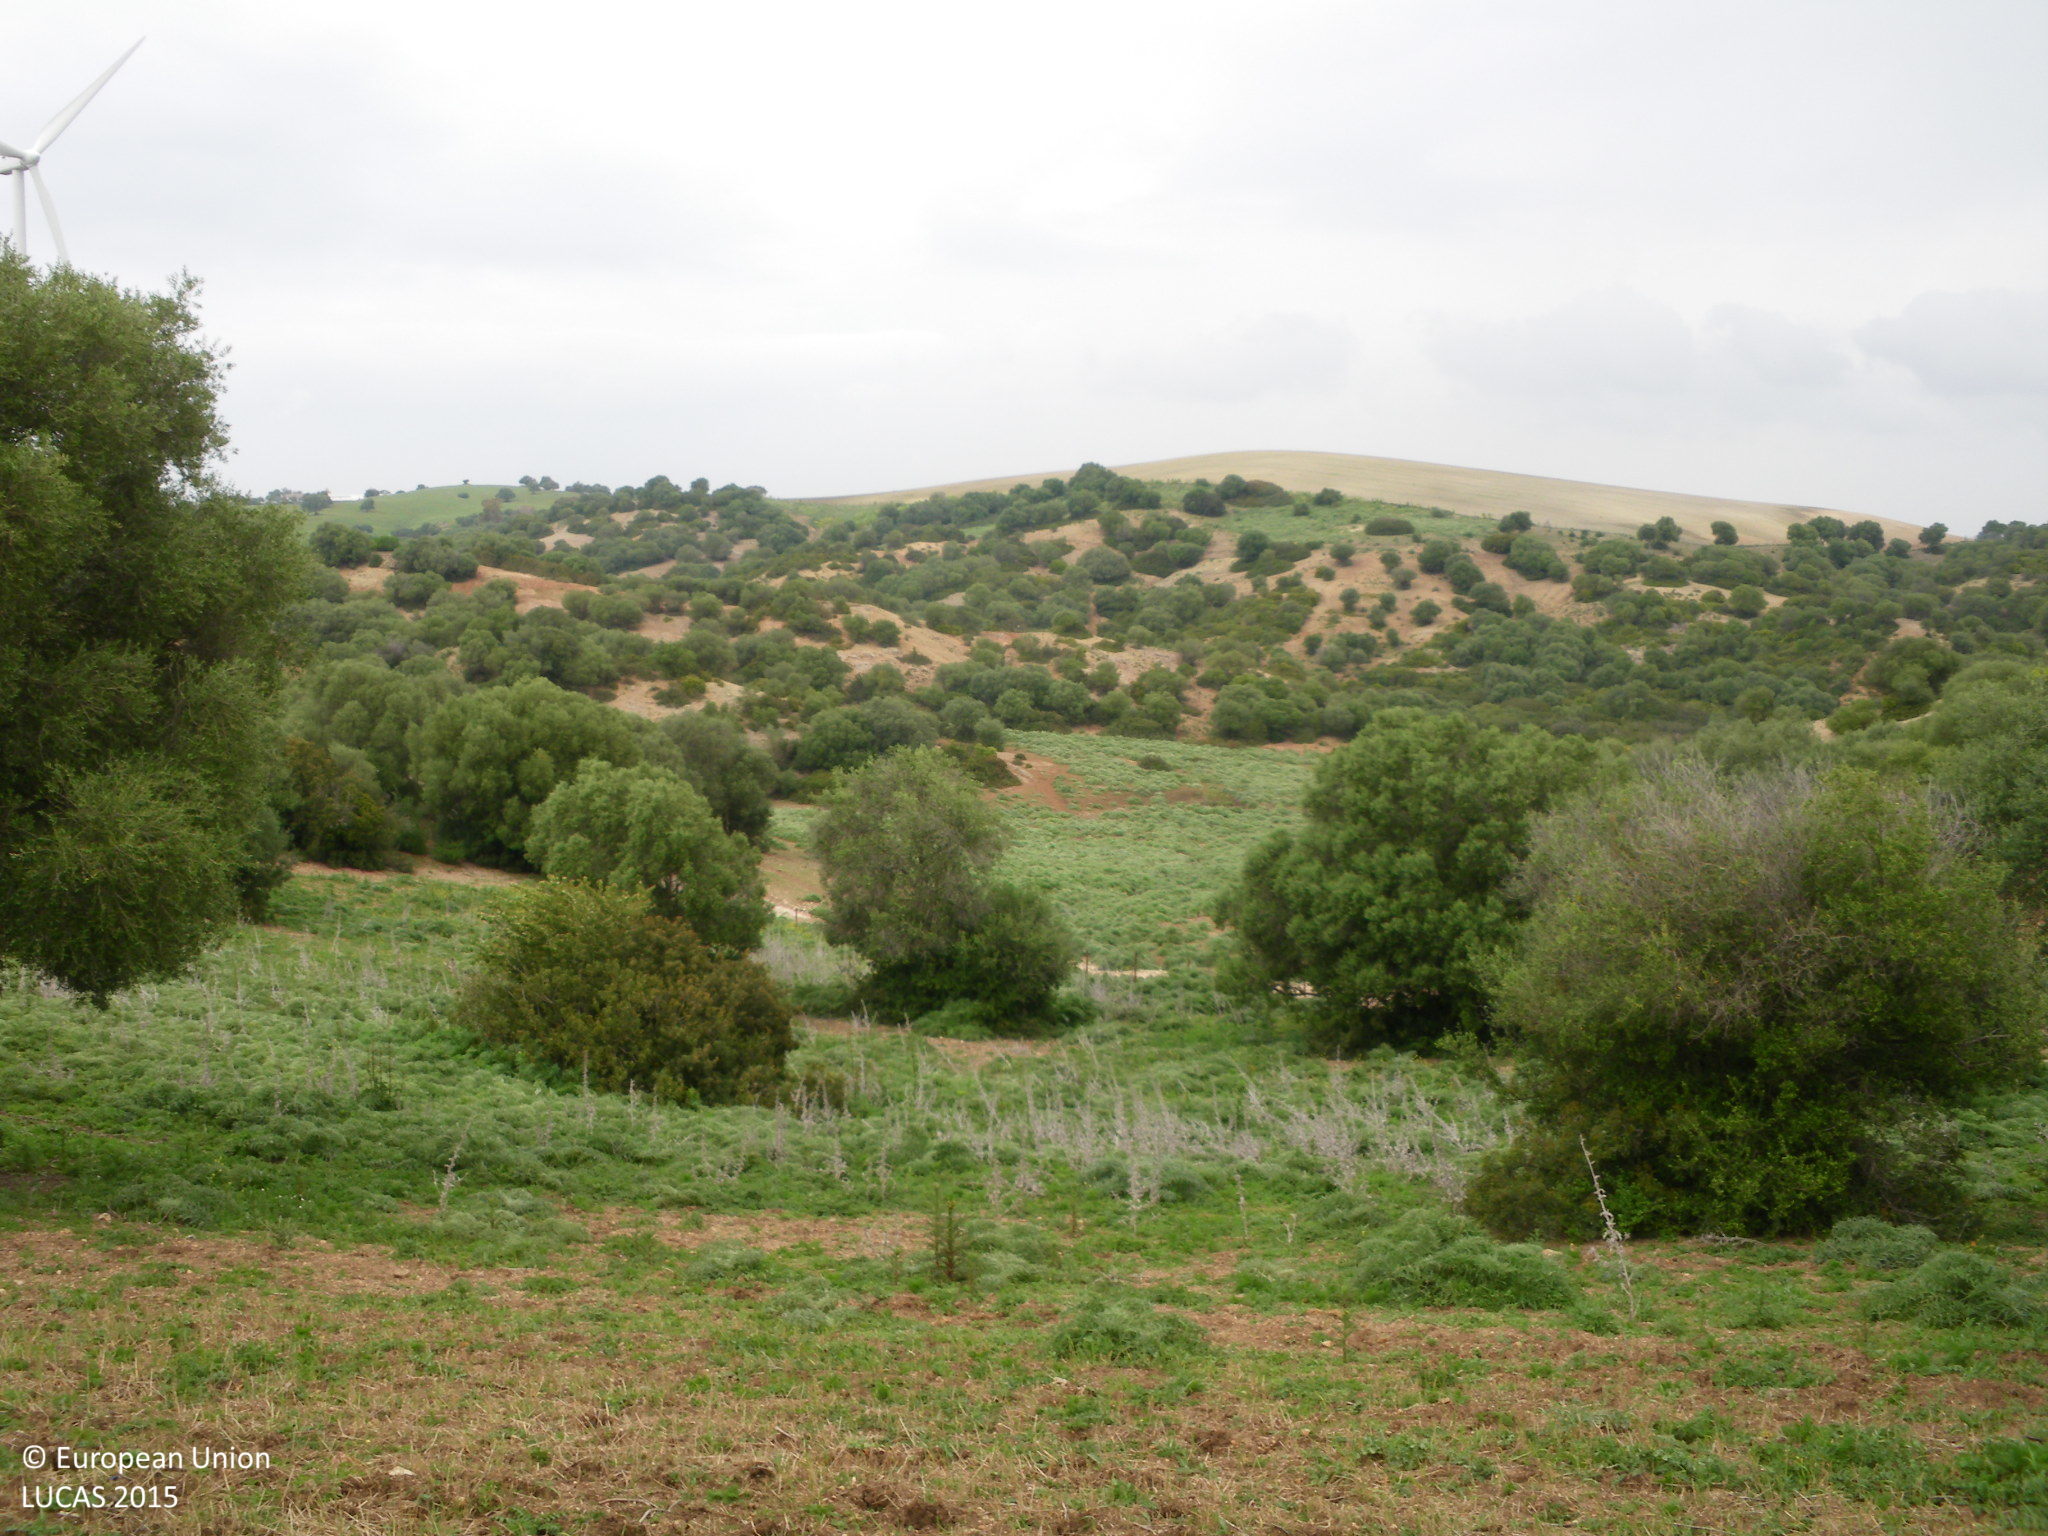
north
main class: Woodland
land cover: Broadleaved woodland
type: broadleaved evergreen forest
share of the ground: 10 - 25 %
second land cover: Spontaneously vegetated surfaces
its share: 50 - 75 %
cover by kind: herbaceous plants 85 %, broadleaved forest trees 15 %
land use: Forestry
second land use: Agriculture (excluding fallow land and kitchen gardens)
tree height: > 5 m
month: April
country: ES
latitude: 36.5896
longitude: -5.9801
